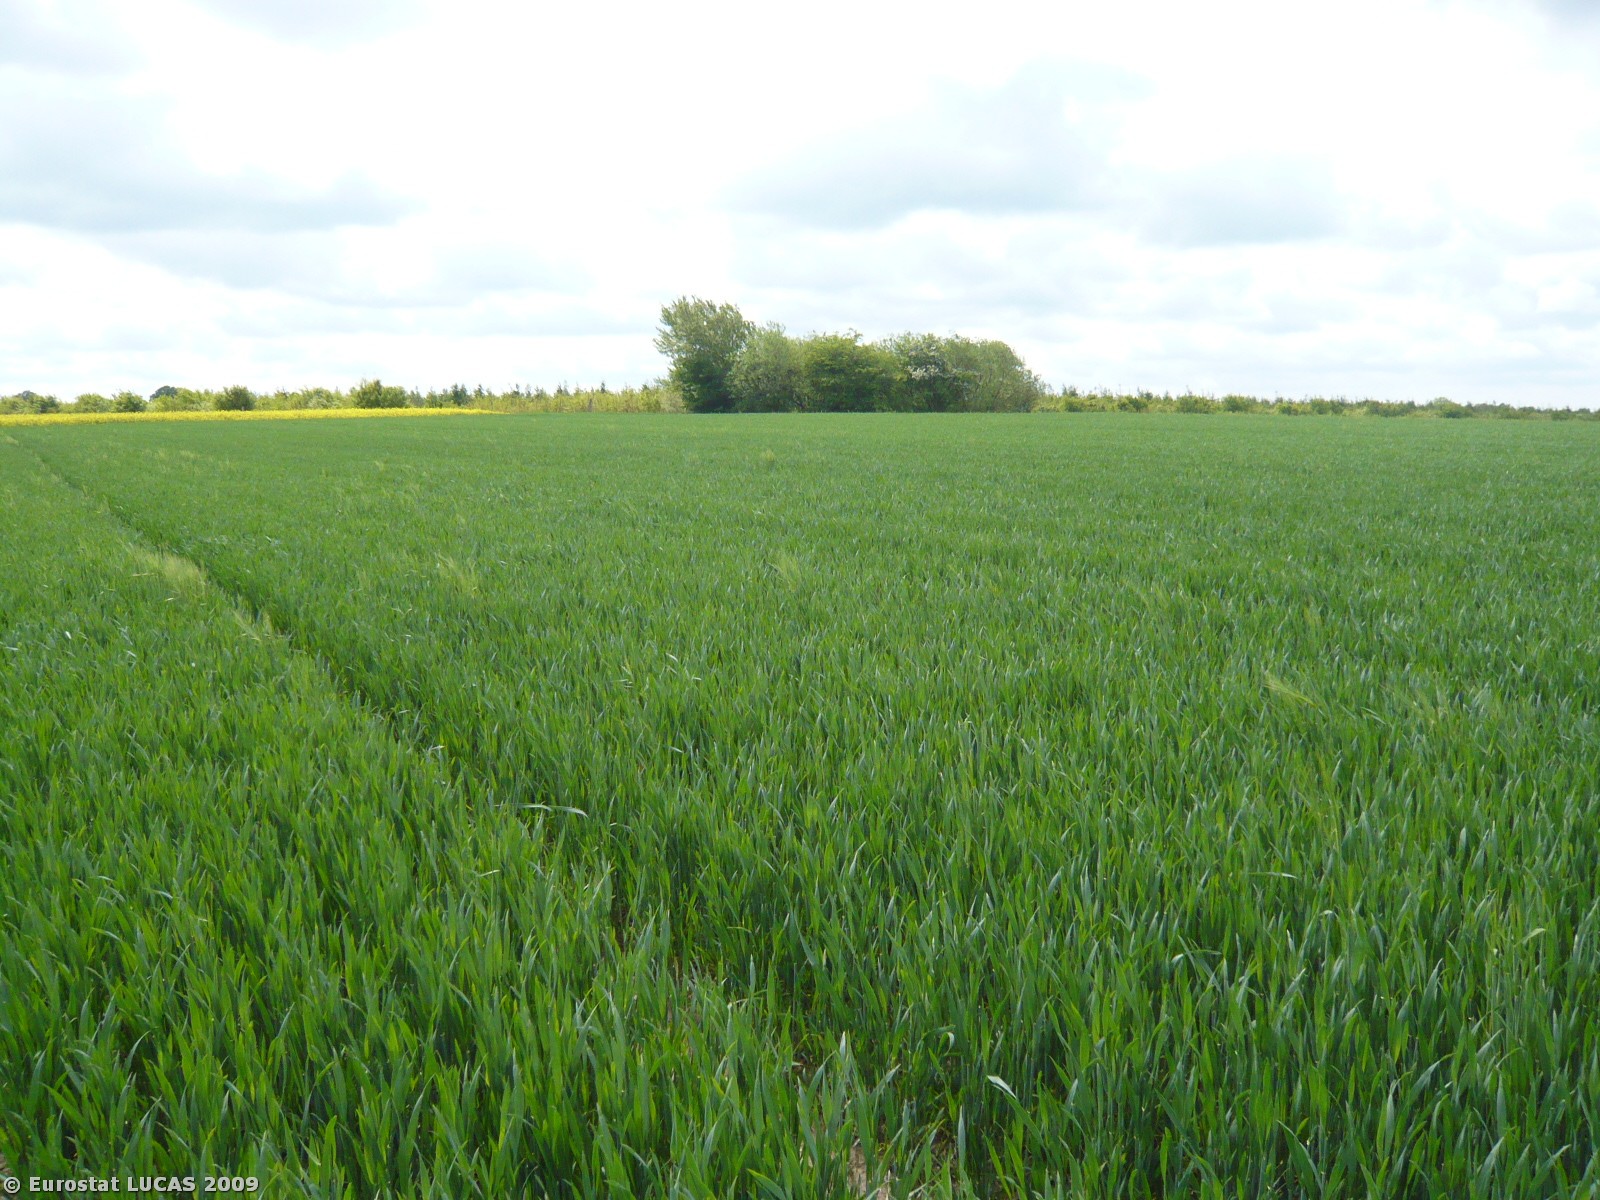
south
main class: Cropland
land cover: Common wheat
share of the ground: > 75 %
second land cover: Barley
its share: < 10 %
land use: Agriculture (excluding fallow land and kitchen gardens)
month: May
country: DK
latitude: 55.4741
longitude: 11.7862
